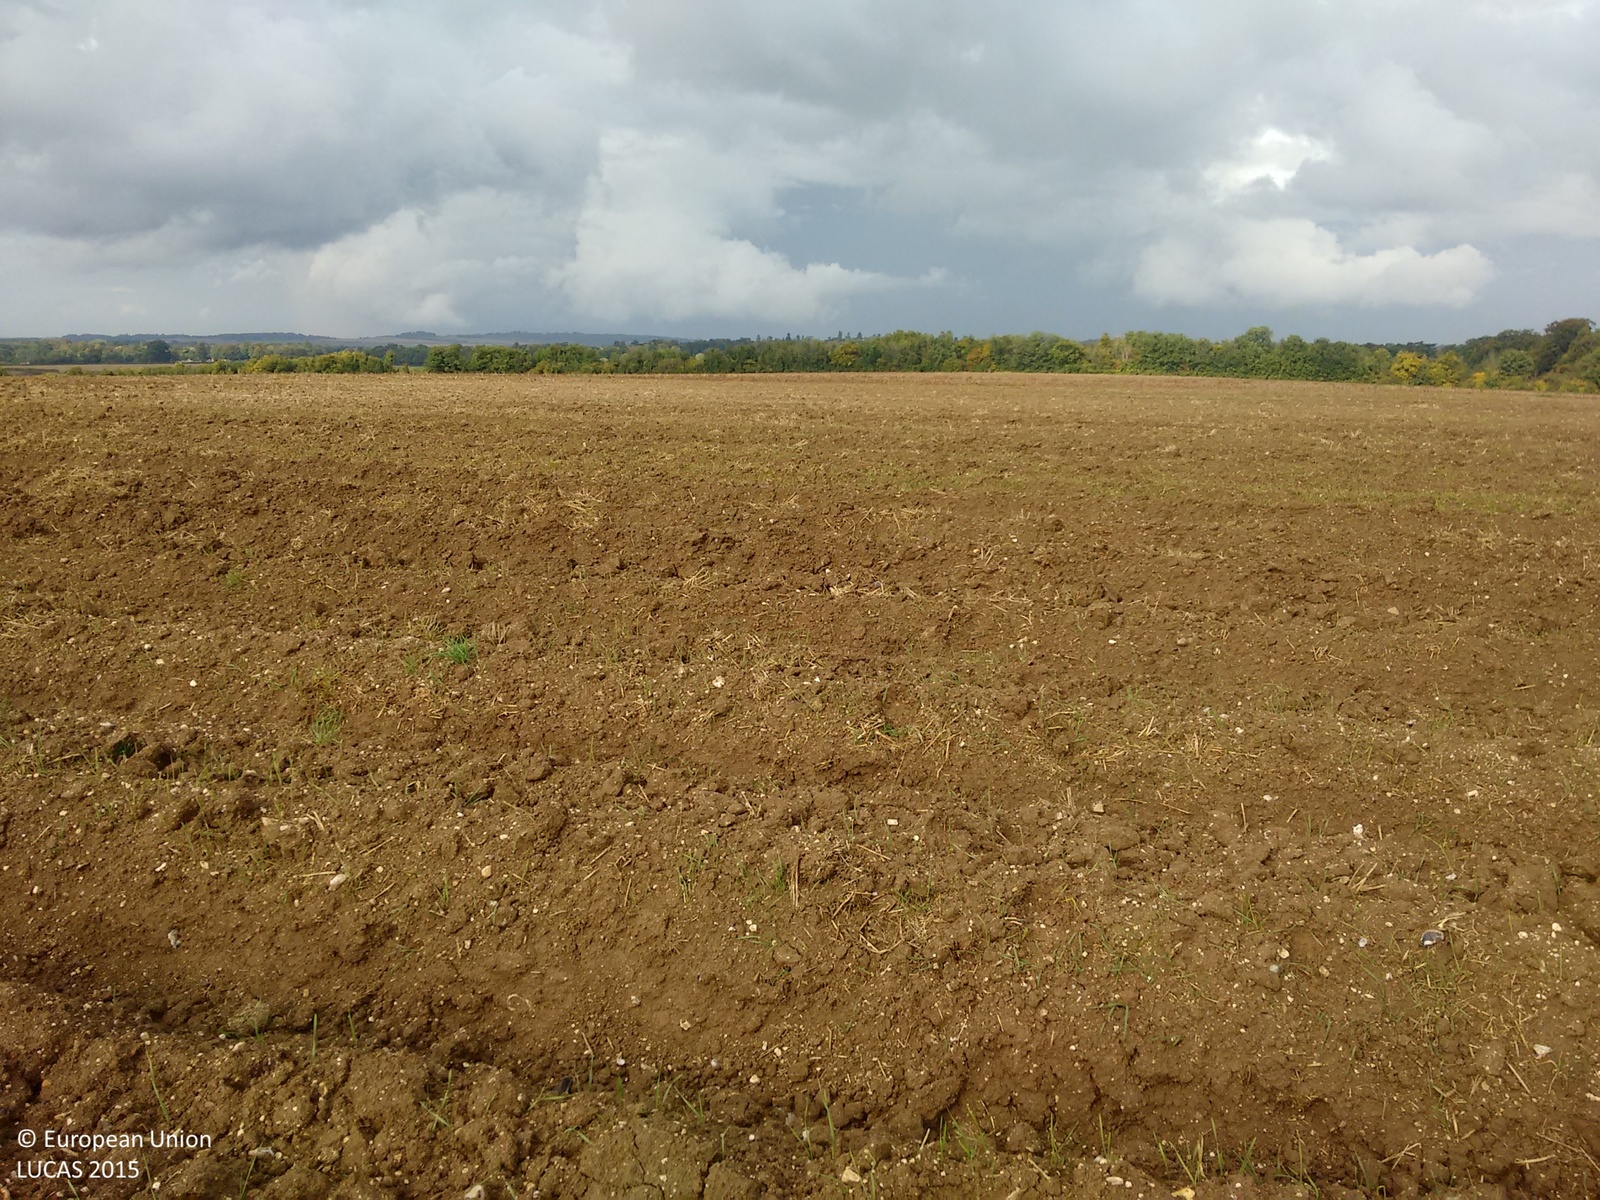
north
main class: Cropland
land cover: Potatoes
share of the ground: < 10 %
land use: Agriculture (excluding fallow land and kitchen gardens)
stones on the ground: < 10 %
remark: Harvested field
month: October
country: GB
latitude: 52.0981
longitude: 0.2034
